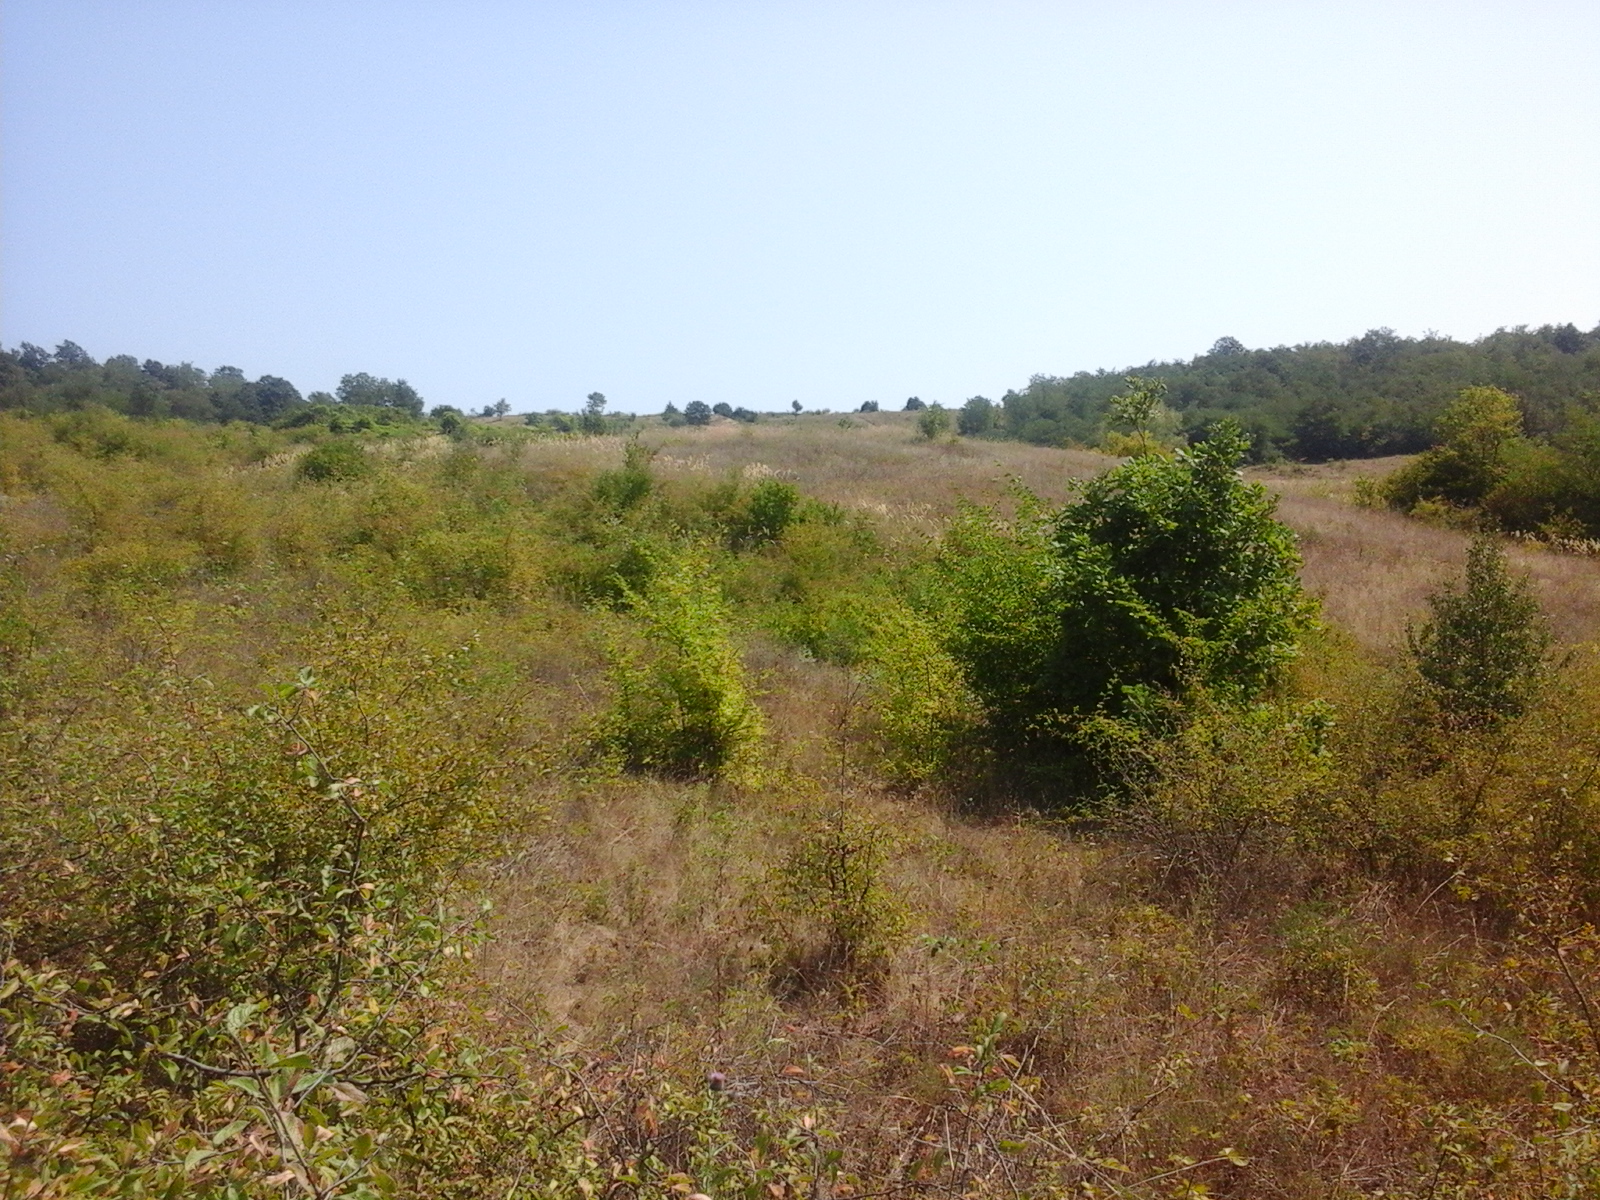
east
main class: Shrubland
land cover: Shrubland with sparse tree cover
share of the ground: > 75 %
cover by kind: shrubs 95 %, broadleaved forest trees 5 %
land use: Semi-natural and natural areas not in use
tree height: < 5 m
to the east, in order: Shrubland with sparse tree cover; Grassland with sparse tree/shrub cover; Grassland without tree/shrub cover; Grassland with sparse tree/shrub cover
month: August
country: RO
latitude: 44.5452
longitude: 23.3299
